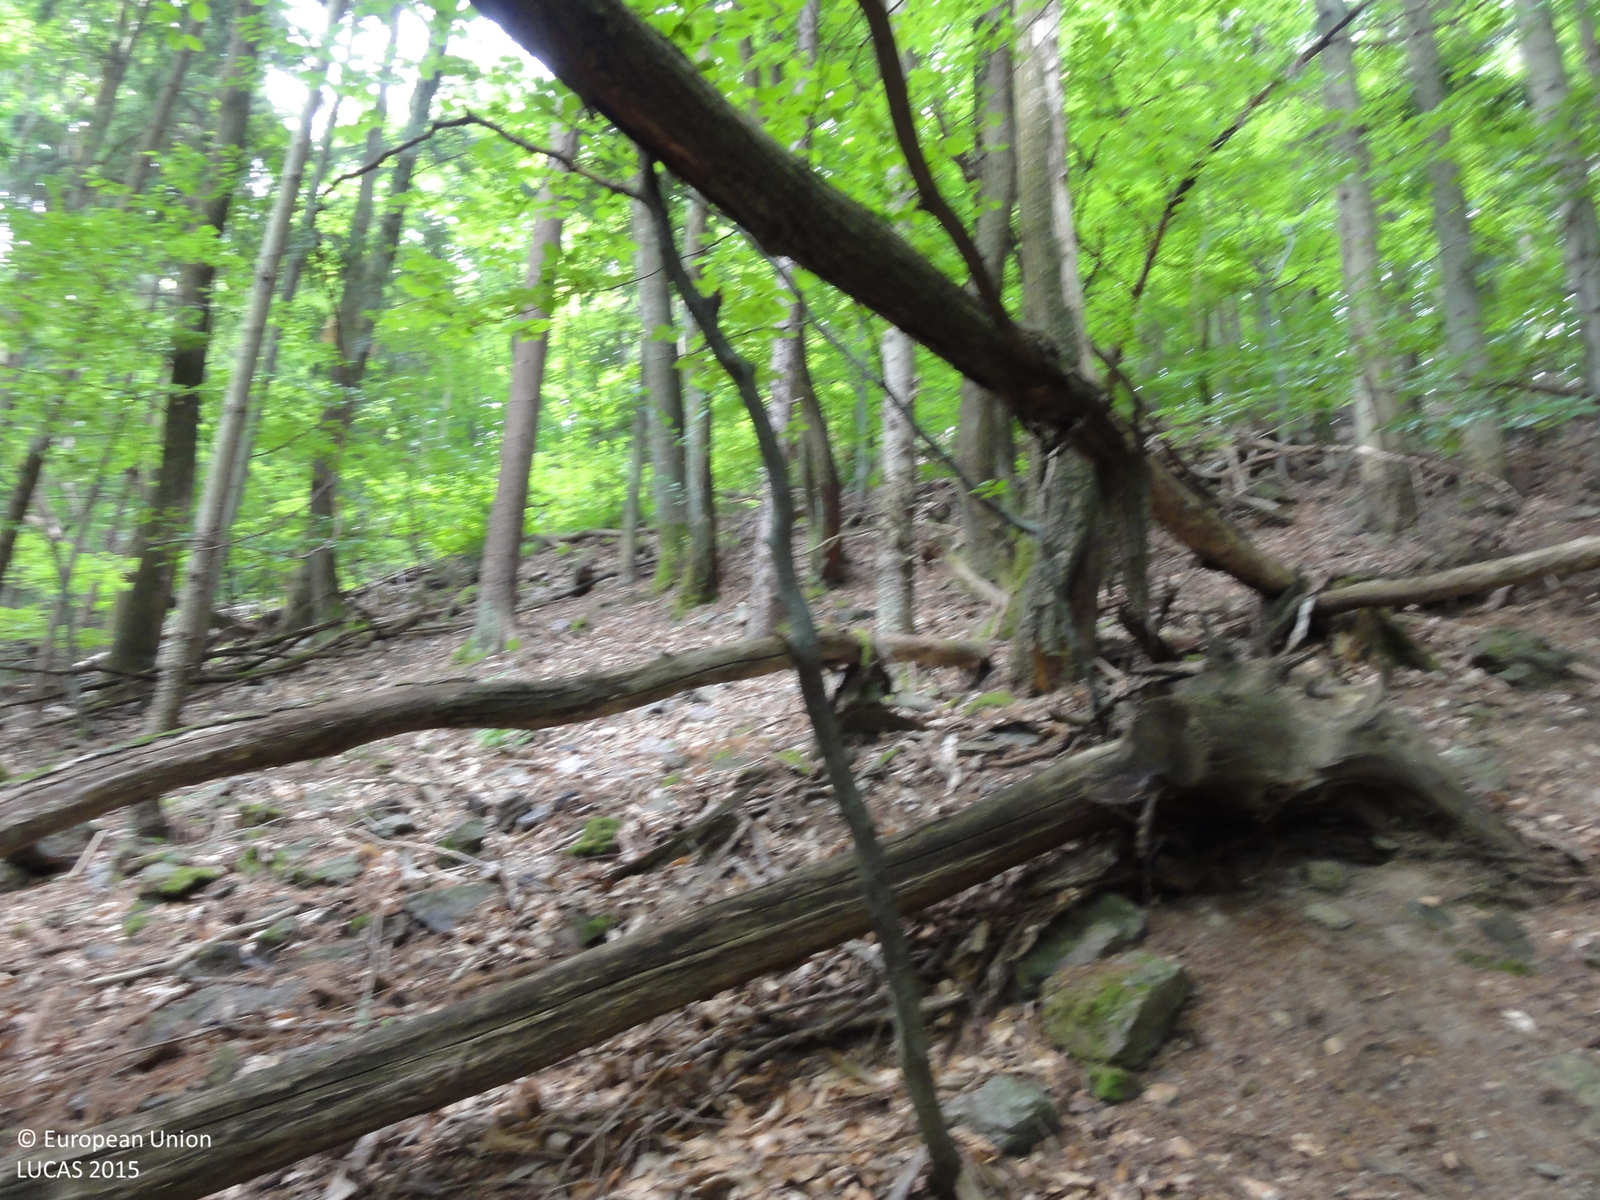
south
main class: Woodland
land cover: Spruce dominated mixed woodland
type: beech forest
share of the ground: > 75 %
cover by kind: broadleaved forest trees 60 %, coniferous forest trees 40 %
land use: Forestry
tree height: > 5 m
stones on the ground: 25 - 50 %
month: July
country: SI
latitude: 46.6030
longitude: 15.5735
